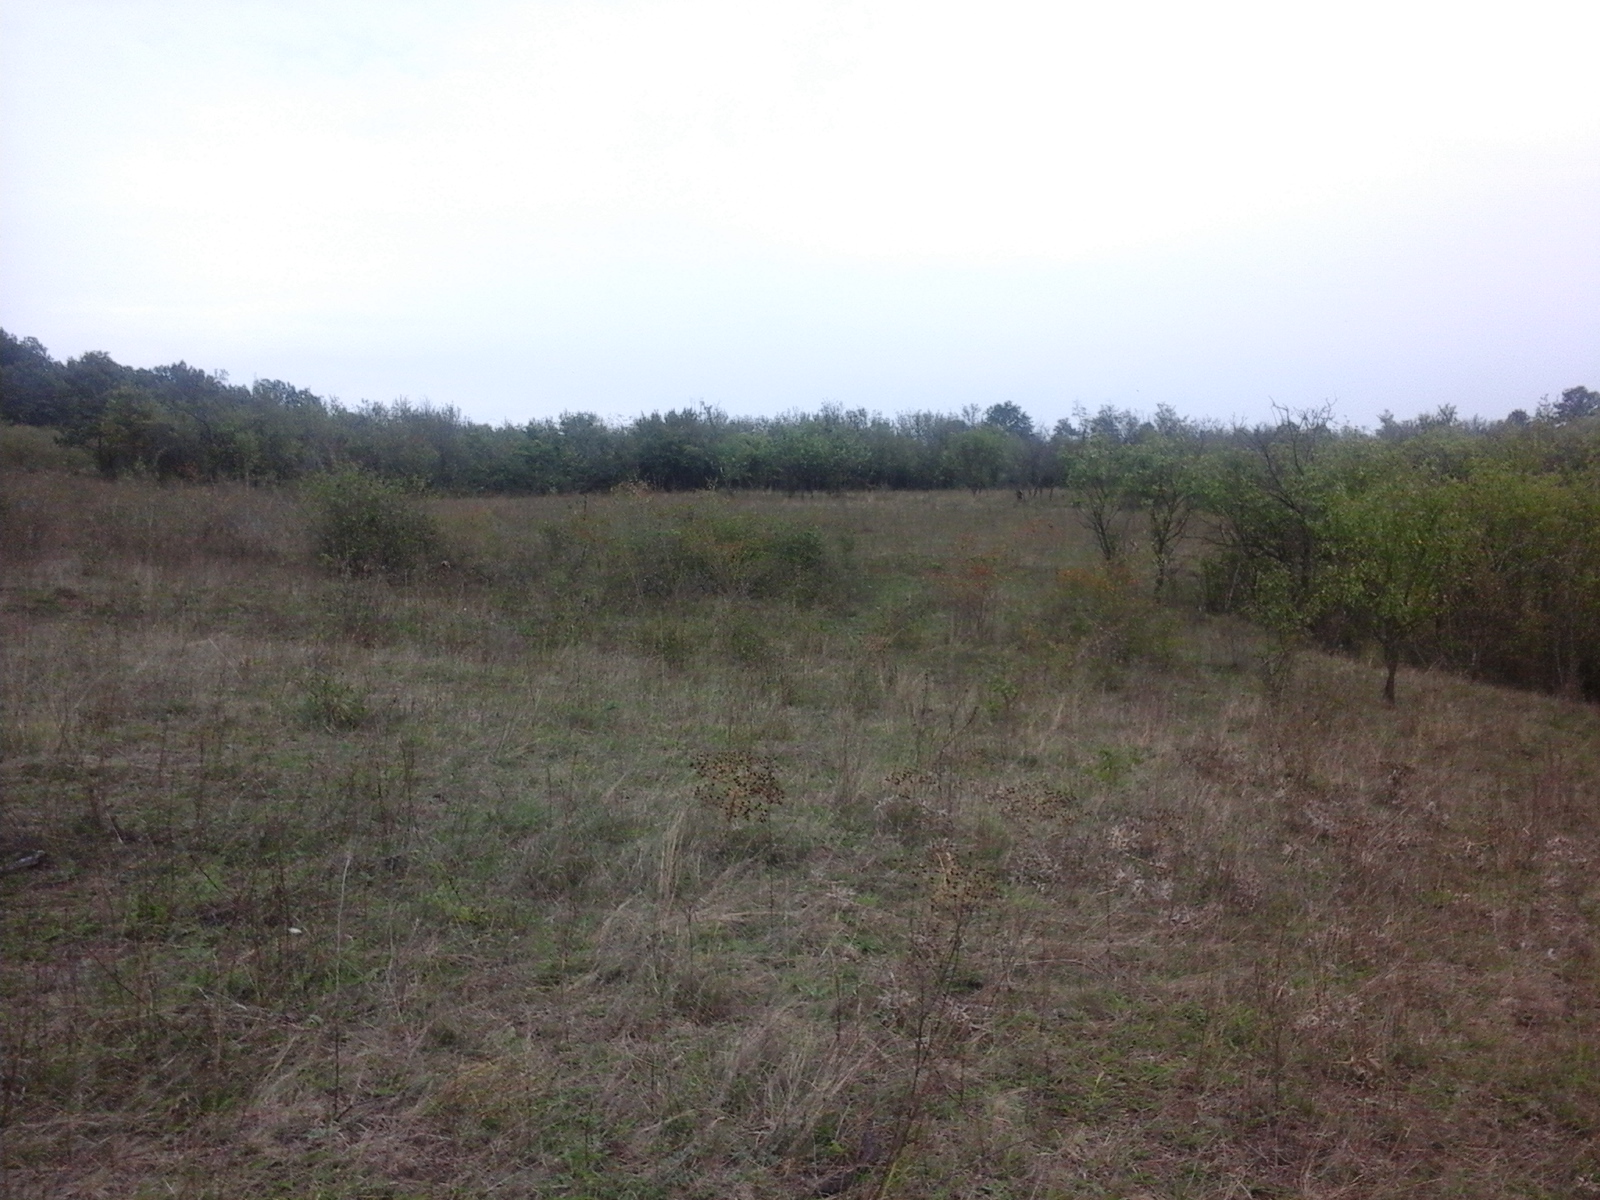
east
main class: Cropland
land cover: Other fruit trees and berries
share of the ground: > 75 %
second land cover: Grassland without tree/shrub cover
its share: > 75 %
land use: Agriculture (excluding fallow land and kitchen gardens)
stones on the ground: < 10 %
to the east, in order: Other fruit trees and berries; Grassland without tree/shrub cover; Broadleaved woodland; Shrubland without tree cover; Grassland with sparse tree/shrub cover
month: September
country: RO
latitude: 45.7576
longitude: 22.9749
